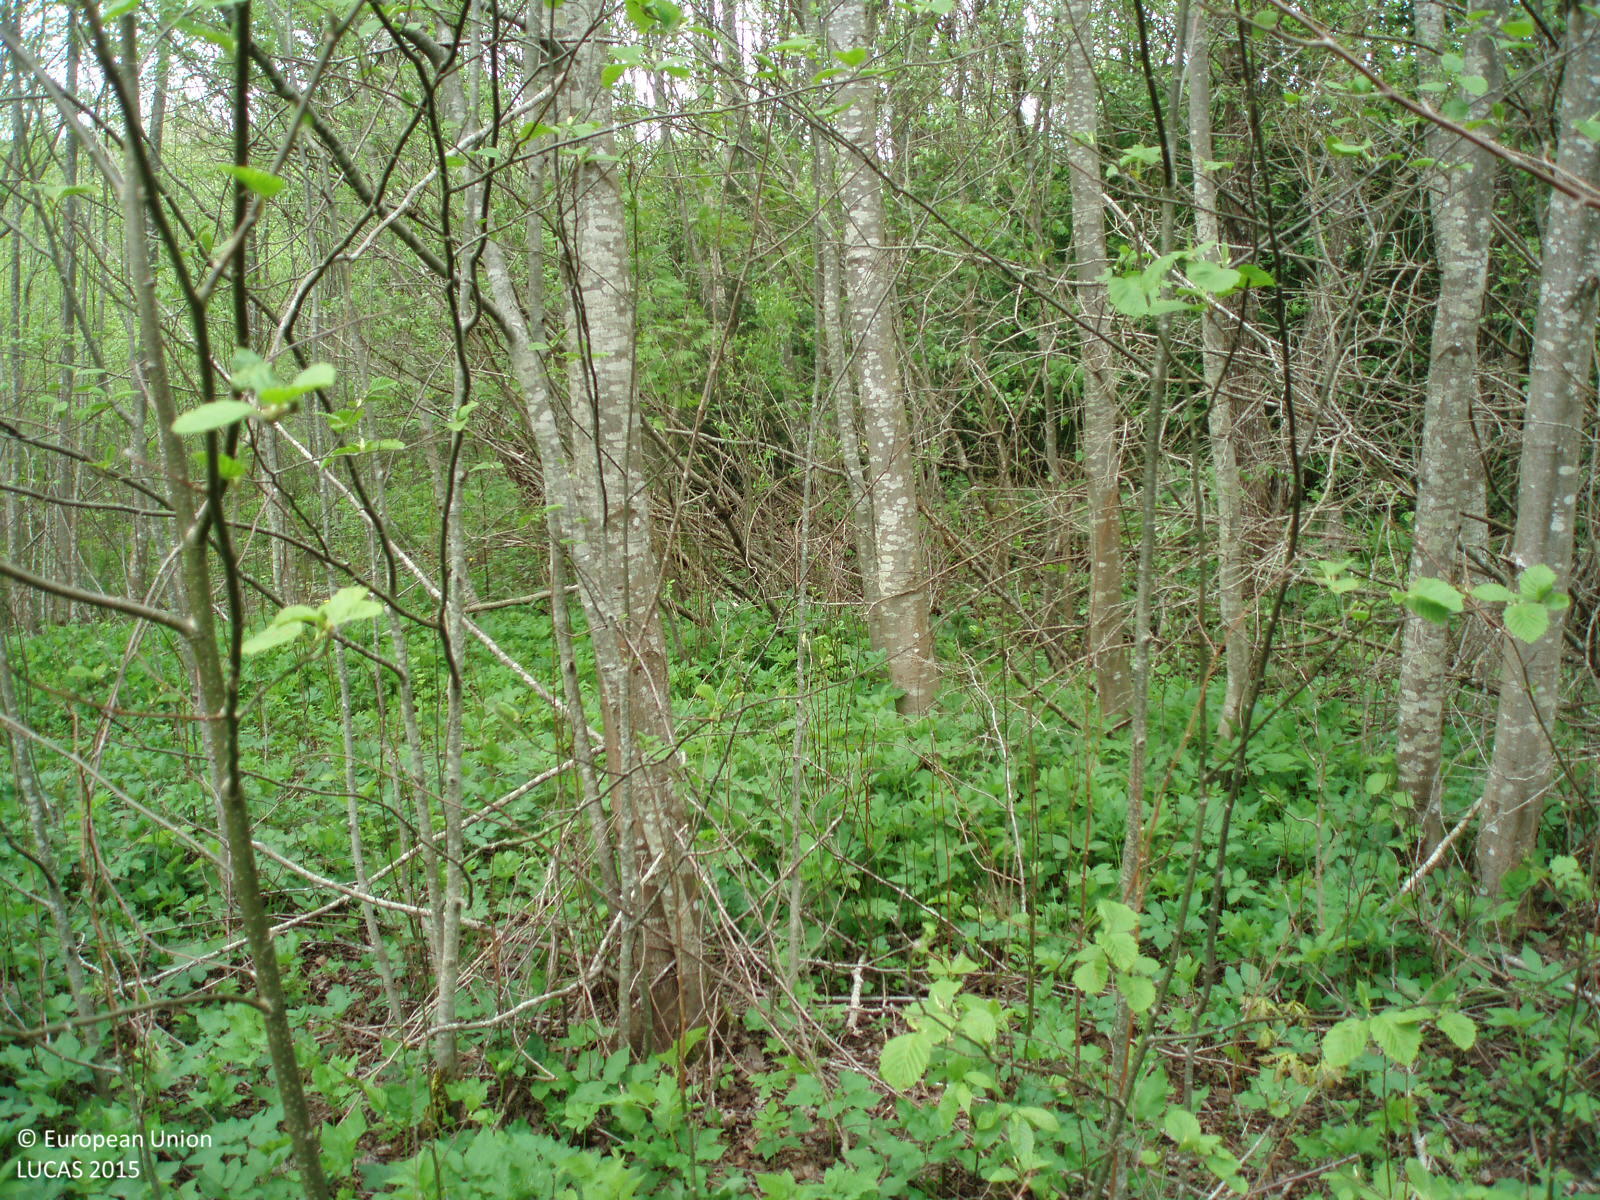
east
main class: Grassland
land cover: Spontaneously vegetated surfaces
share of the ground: > 75 %
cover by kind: herbaceous plants 100 %
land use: Semi-natural and natural areas not in use
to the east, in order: Broadleaved woodland; Fences; Grass margins; Paved roads, cycling and walking lanes; Shruby margins; Ditches and canals; Broadleaved woodland; Spruce dominated mixed woodland
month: May
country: LT
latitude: 56.3275
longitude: 22.4283
